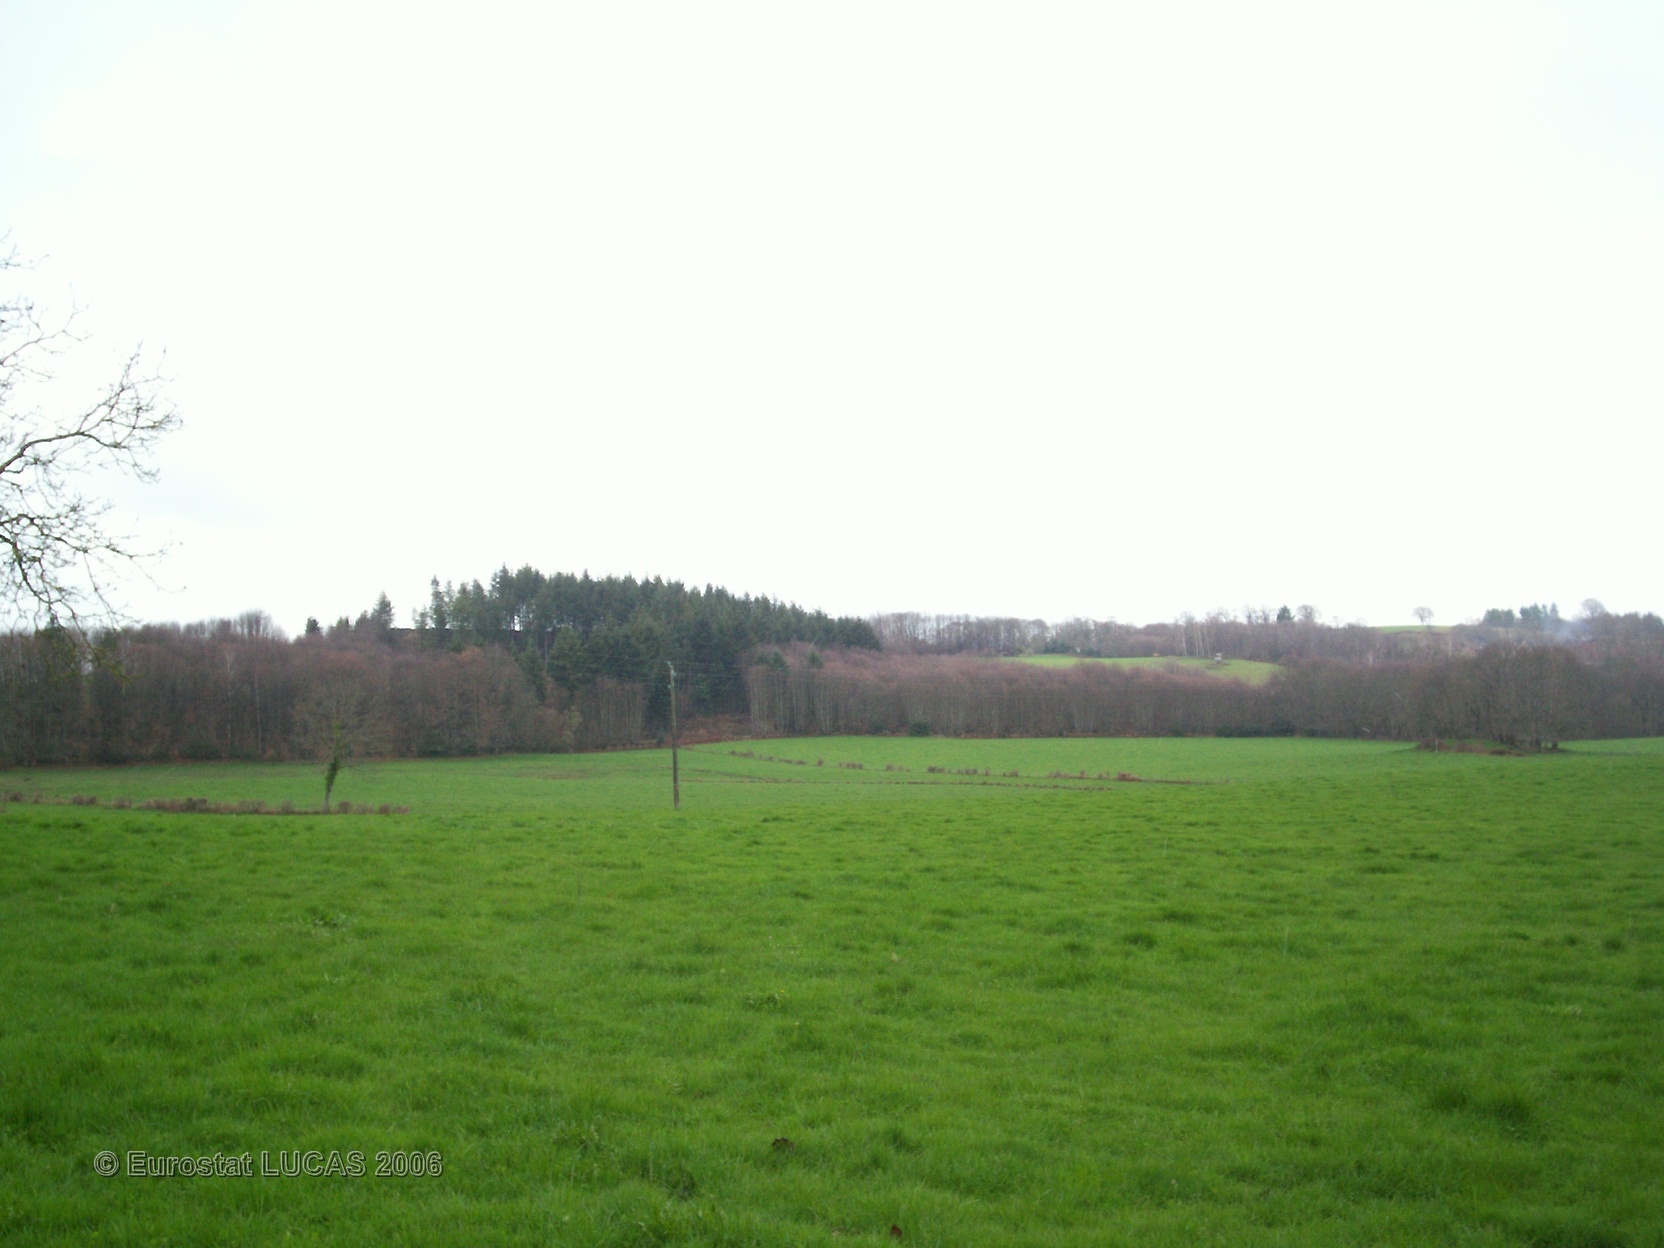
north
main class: Grassland
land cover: Grassland with sparse tree/shrub cover
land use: Agriculture (excluding fallow land and kitchen gardens)
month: April
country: FR
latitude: 45.5678
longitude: 1.6014
